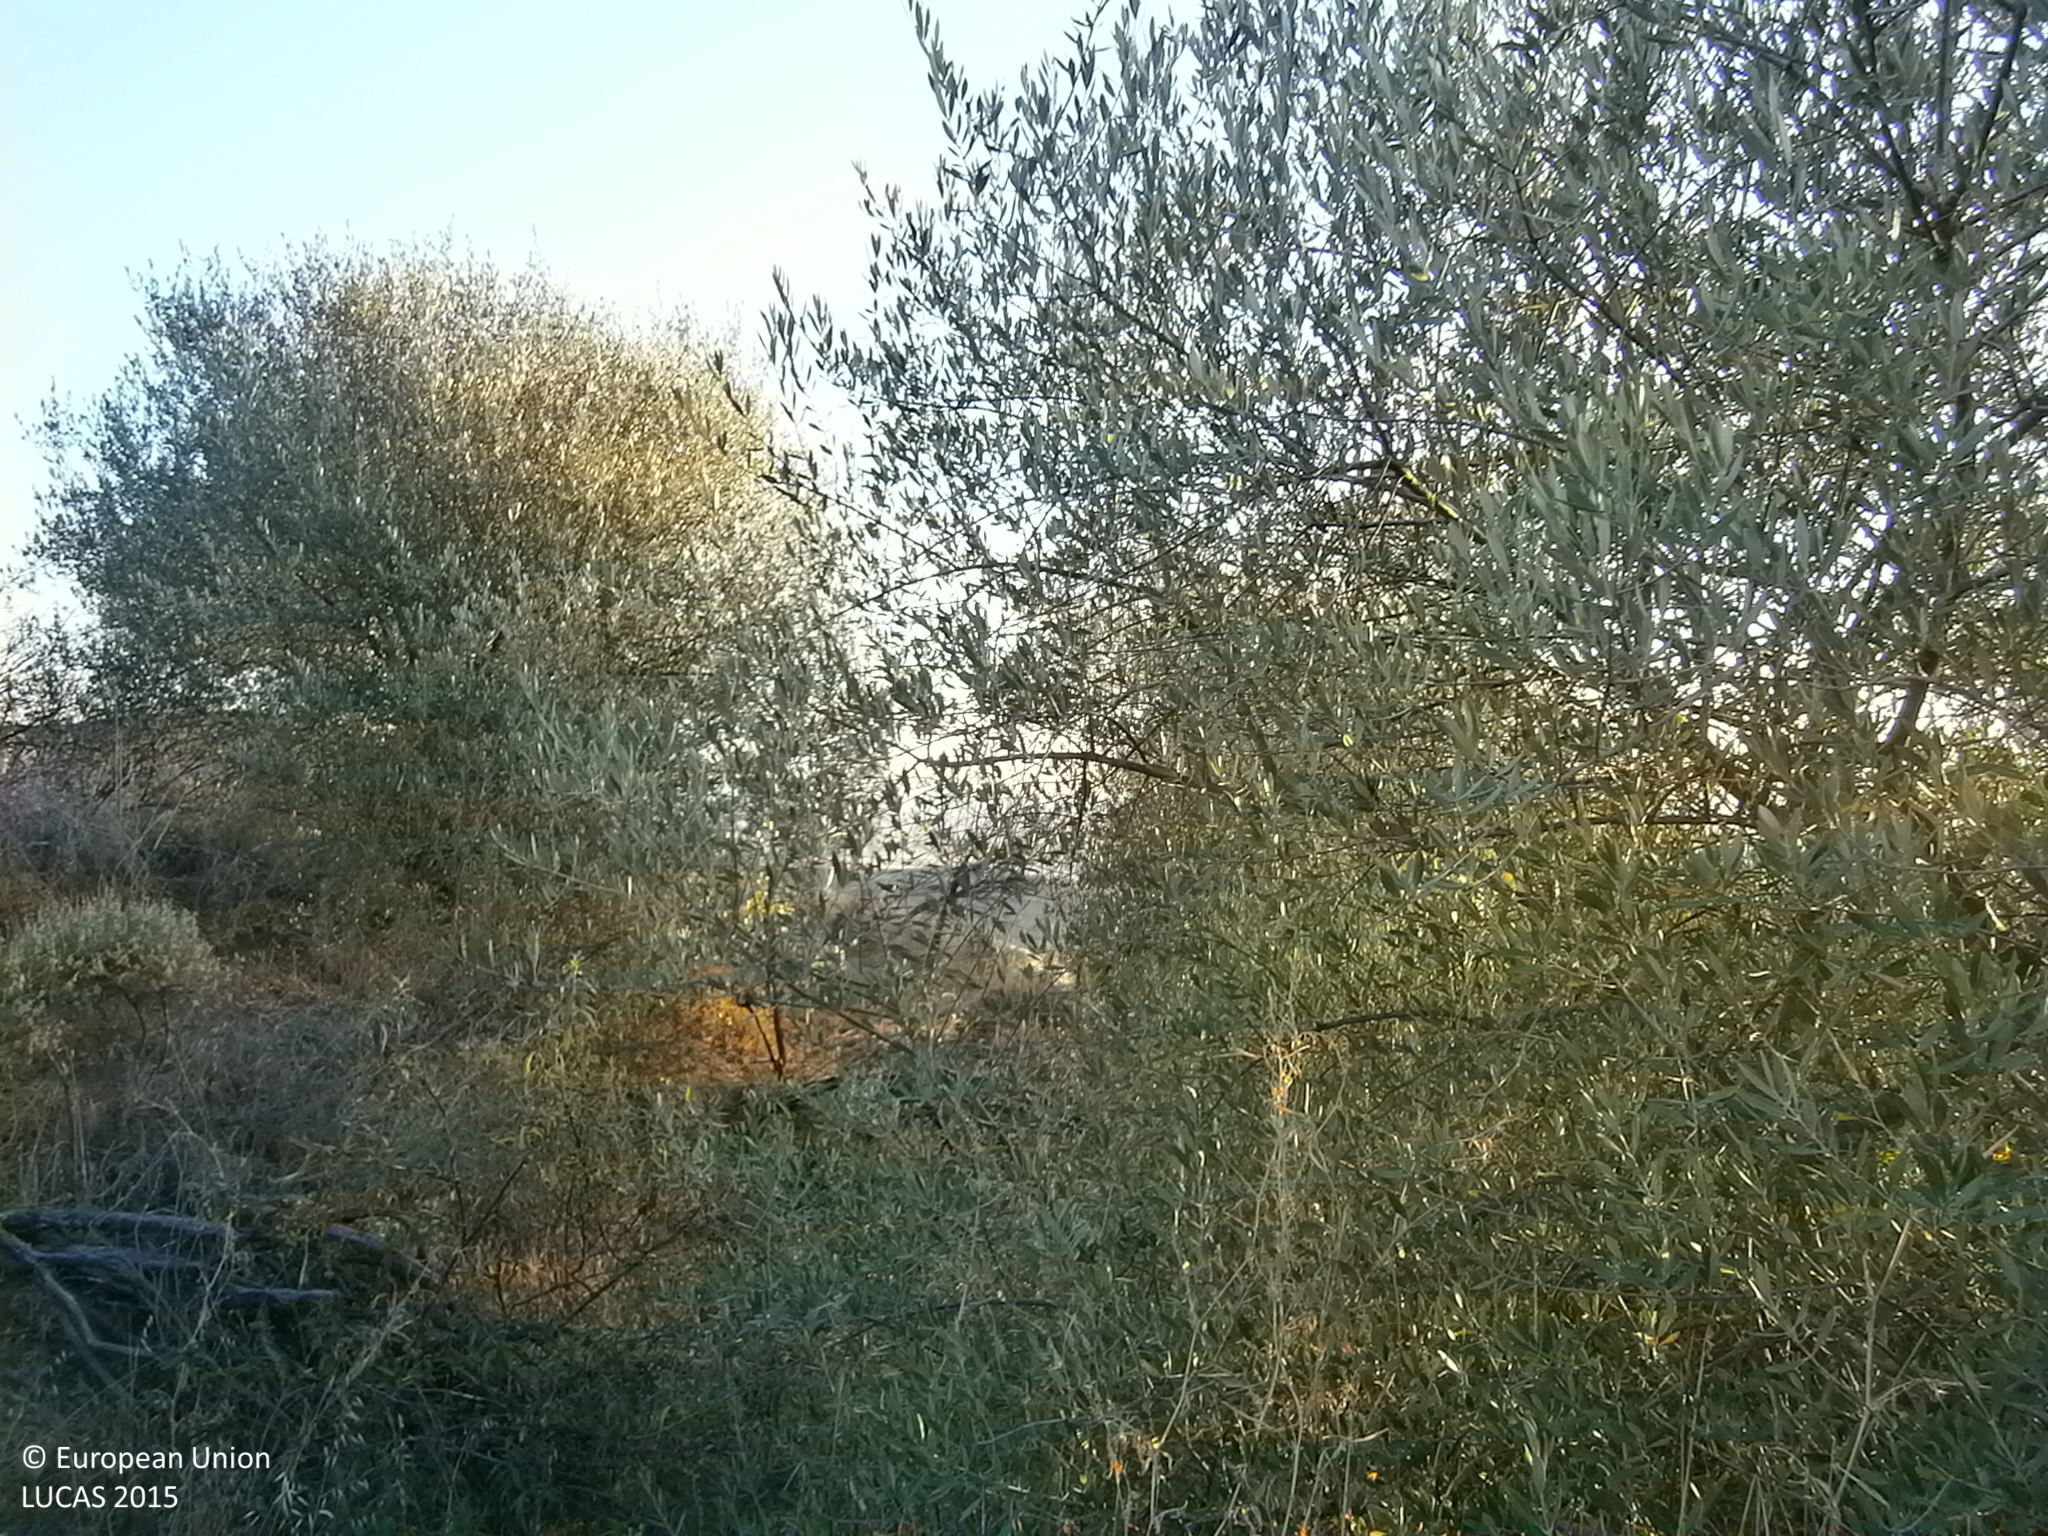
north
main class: Shrubland
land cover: Shrubland with sparse tree cover
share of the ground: > 75 %
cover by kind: shrubs 95 %, broadleaved forest trees 5 %
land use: Forestry
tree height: > 5 m
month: June
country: ES
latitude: 38.5625
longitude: -6.6171
